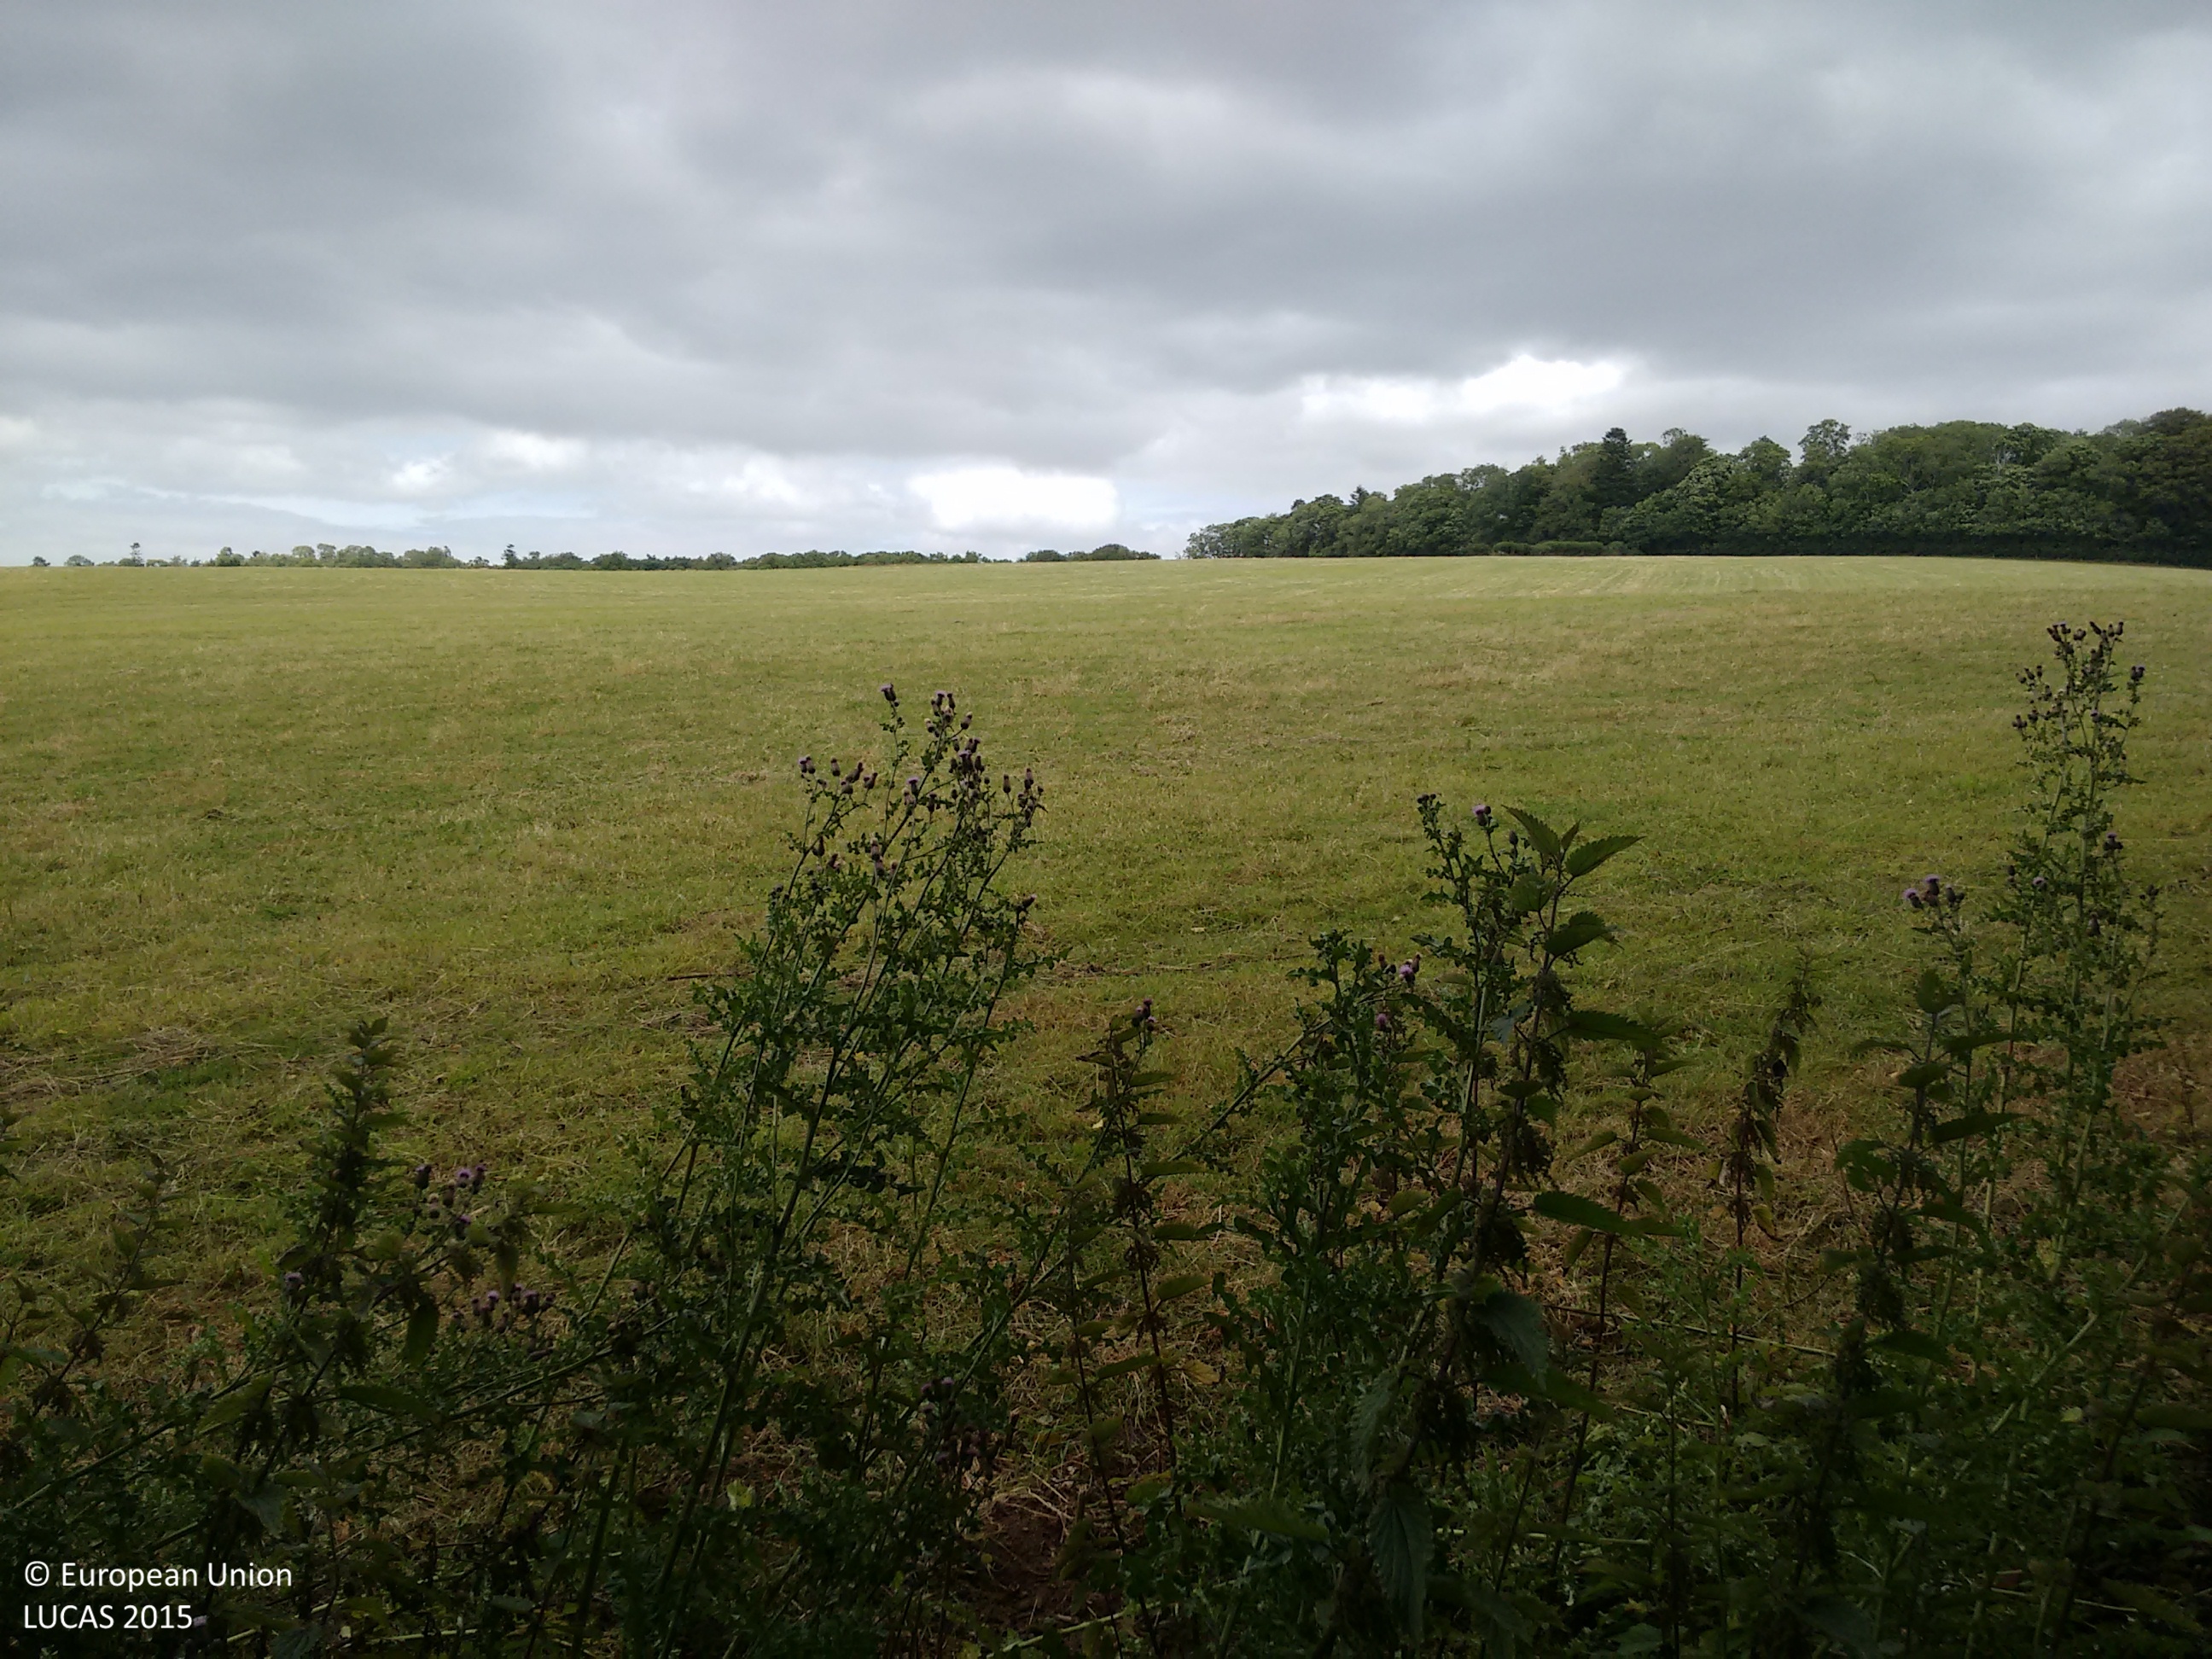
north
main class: Grassland
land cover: Grassland without tree/shrub cover
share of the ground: > 75 %
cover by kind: herbaceous plants 100 %
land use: Agriculture (excluding fallow land and kitchen gardens)
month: August
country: GB
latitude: 50.5896
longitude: -3.5747
